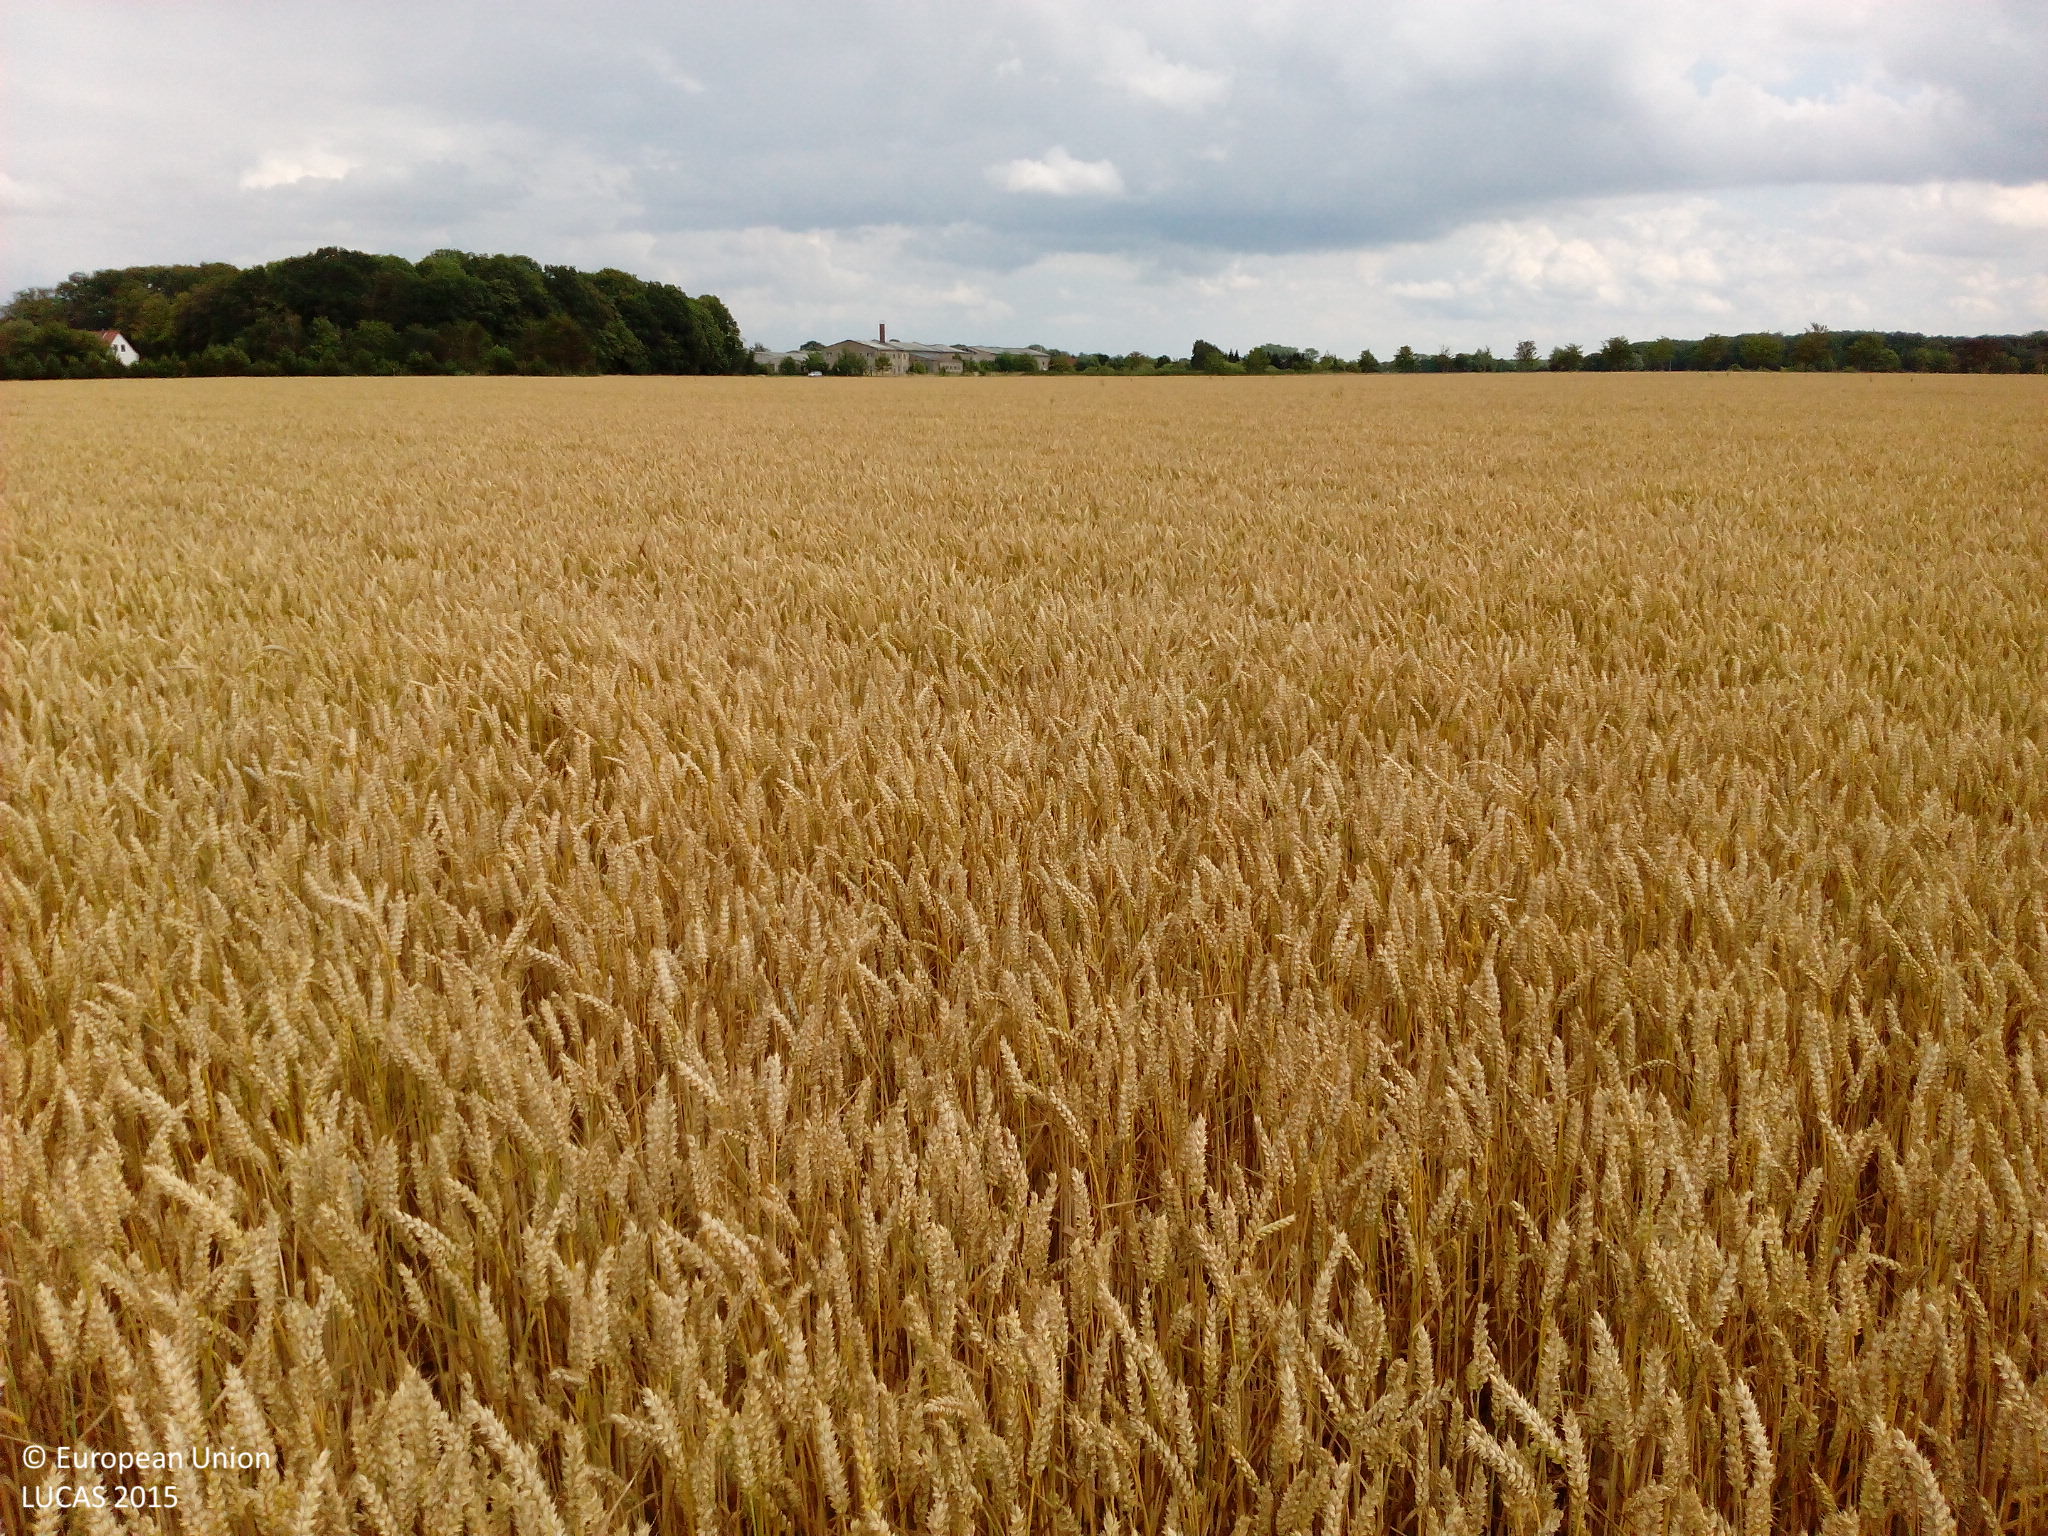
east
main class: Cropland
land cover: Common wheat
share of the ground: > 75 %
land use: Agriculture (excluding fallow land and kitchen gardens)
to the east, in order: Common wheat
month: July
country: DE
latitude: 54.2720
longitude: 12.6556
